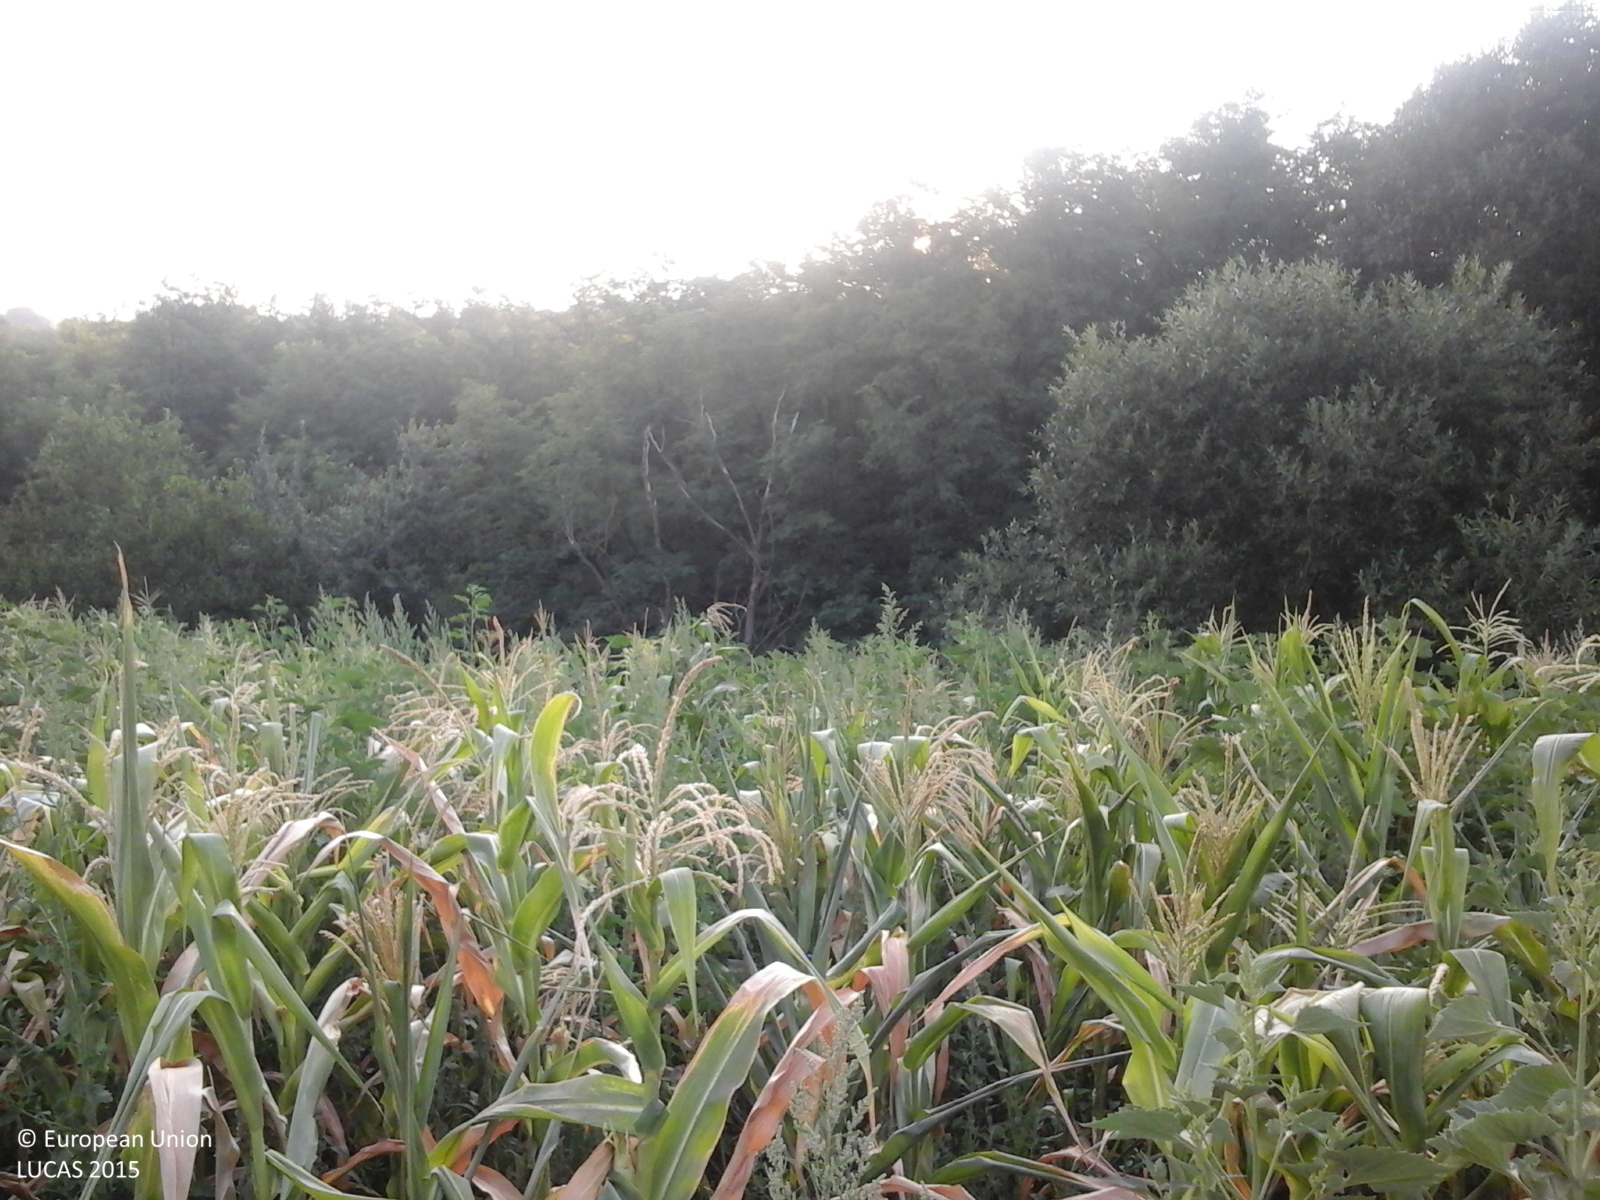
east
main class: Grassland
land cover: Spontaneously vegetated surfaces
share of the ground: > 75 %
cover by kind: herbaceous plants 100 %
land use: Fallow land
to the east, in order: Spontaneously vegetated surfaces; Broadleaved woodland; Maize; Grass margins; Tracks; Grass margins; Maize; Broadleaved woodland
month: July
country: RO
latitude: 46.4655
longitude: 27.6828
